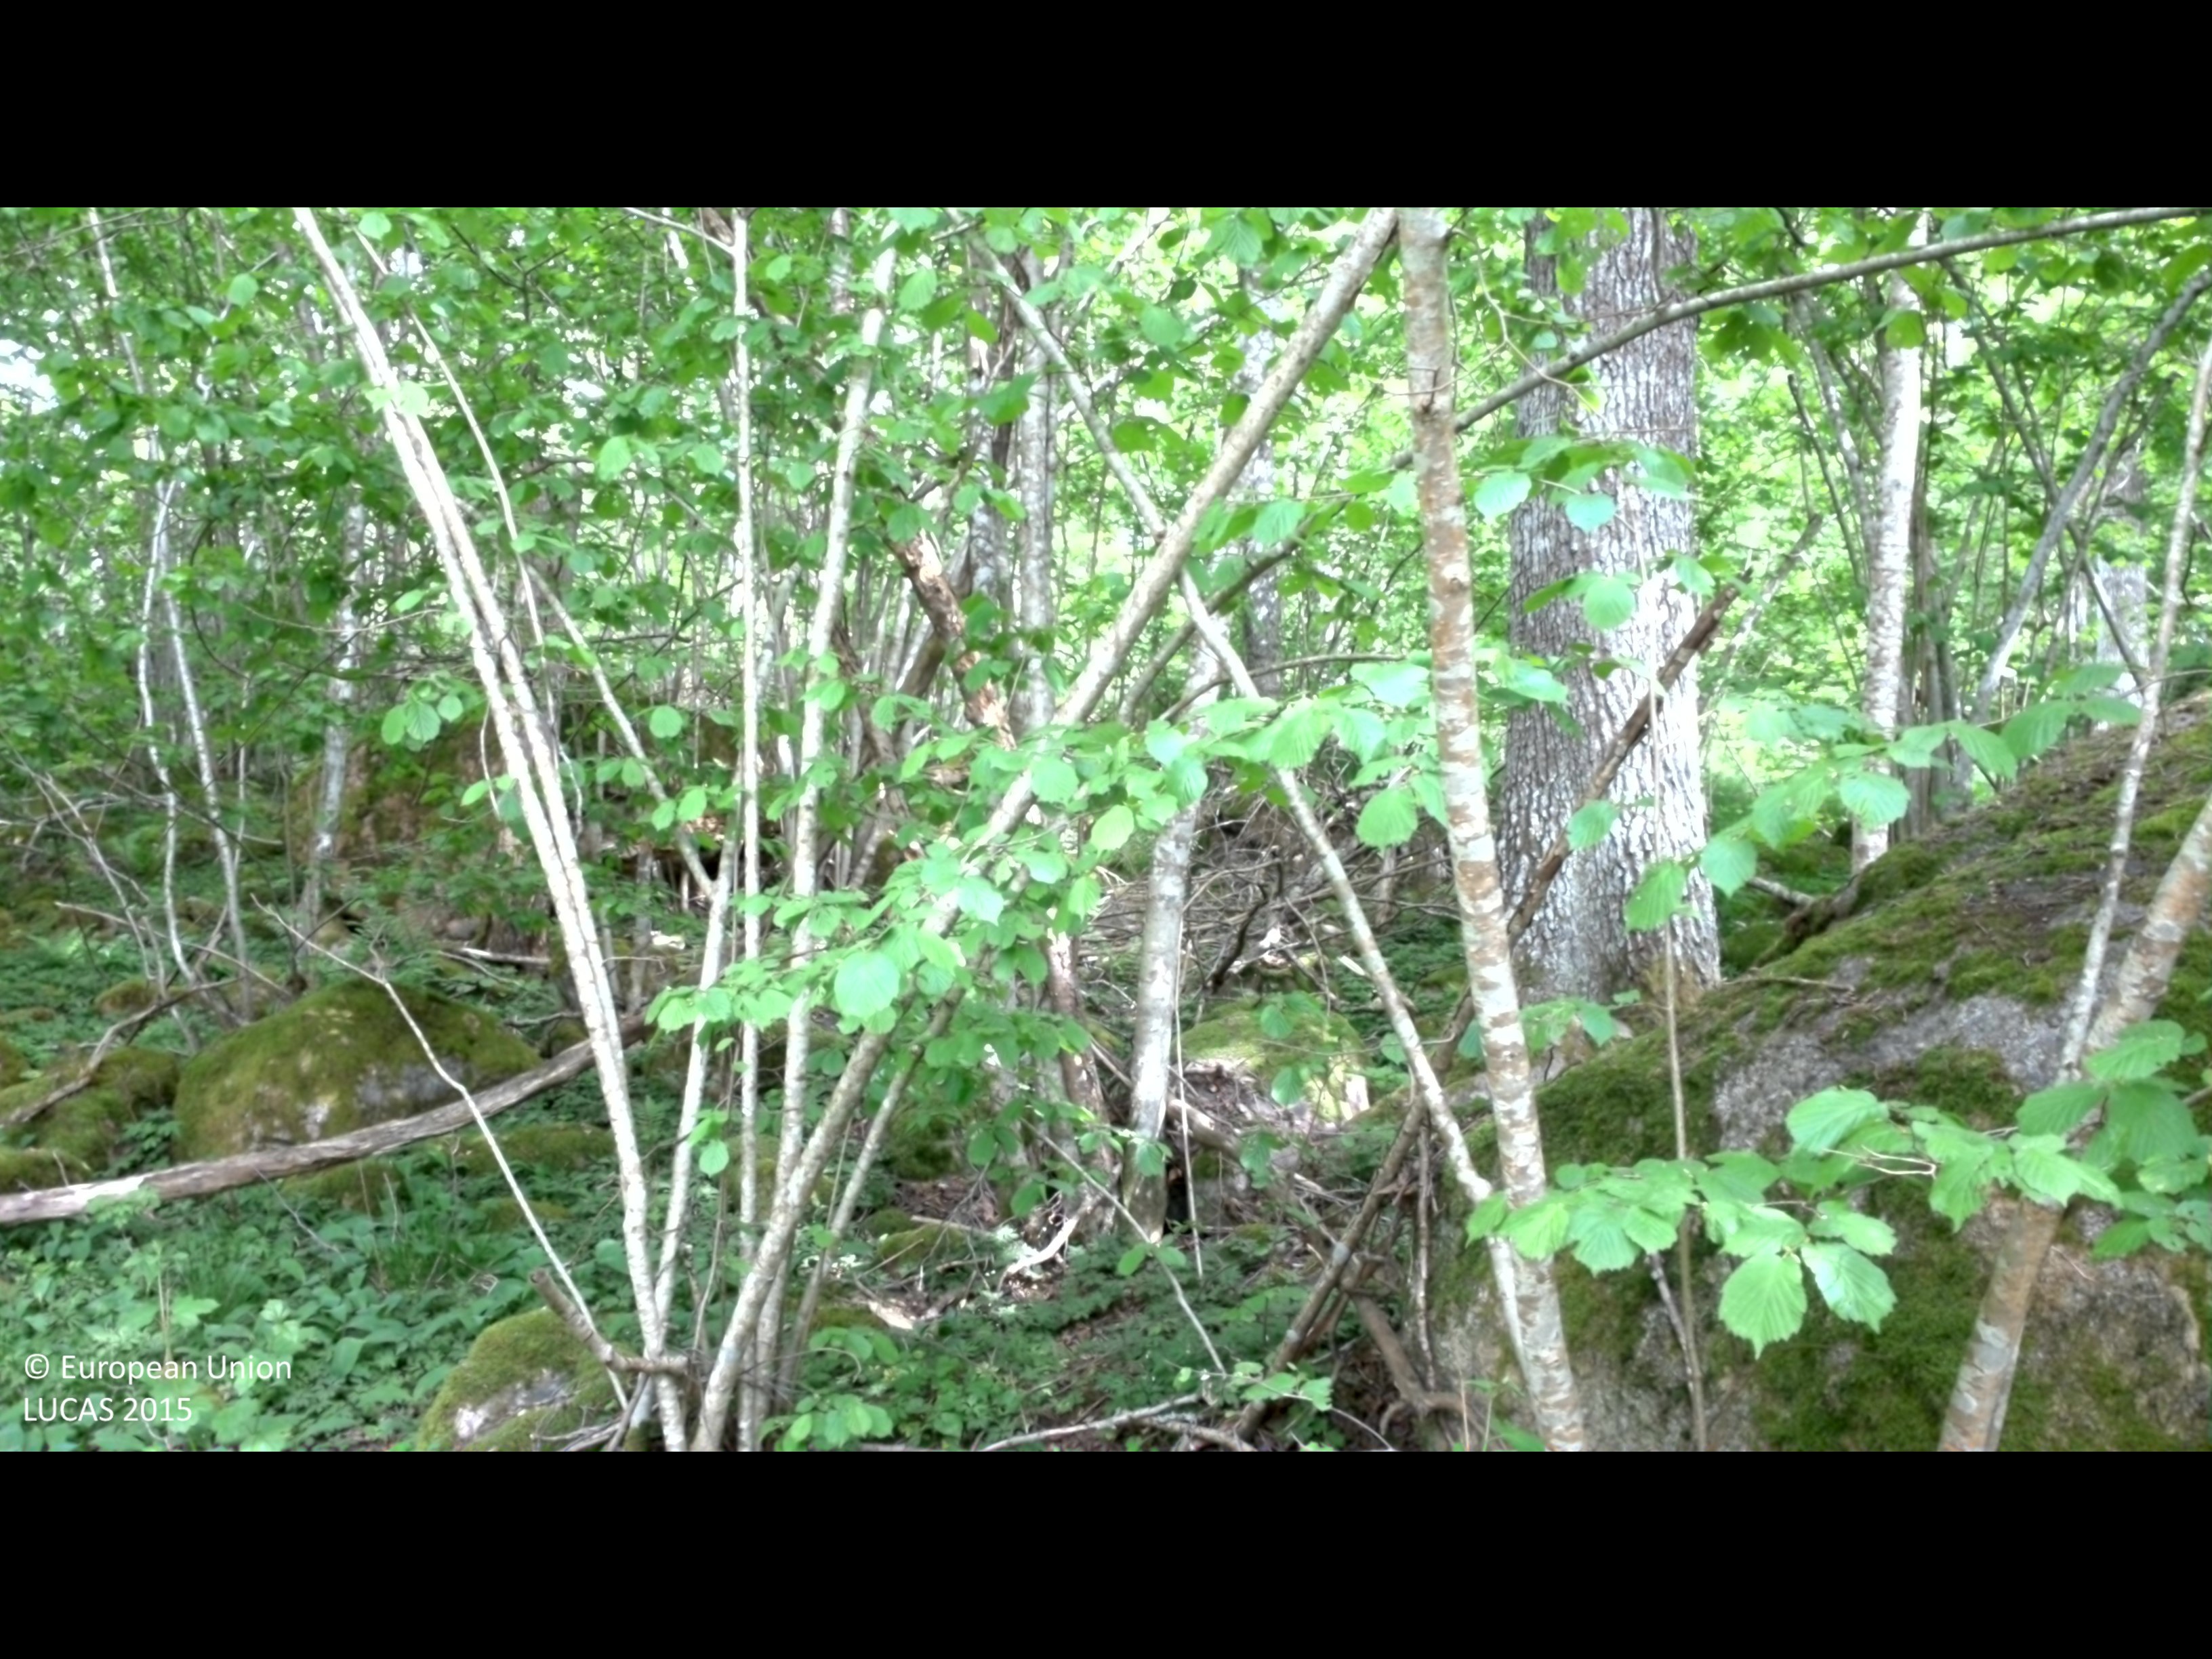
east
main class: Woodland
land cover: Broadleaved woodland
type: hemiboreal forest and nemoral coniferous forest and mixed broadleaved-coniferous forest
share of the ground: > 75 %
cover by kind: broadleaved forest trees 85 %, shrubs 15 %
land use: Forestry
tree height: > 5 m
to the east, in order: Broadleaved woodland; Ditches and canals; Broadleaved woodland; Spruce dominated coniferous woodland; Pine dominated coniferous woodland; Broadleaved woodland; Ditches and canals; Broadleaved woodland
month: May
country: SE
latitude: 57.3779
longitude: 16.4691
